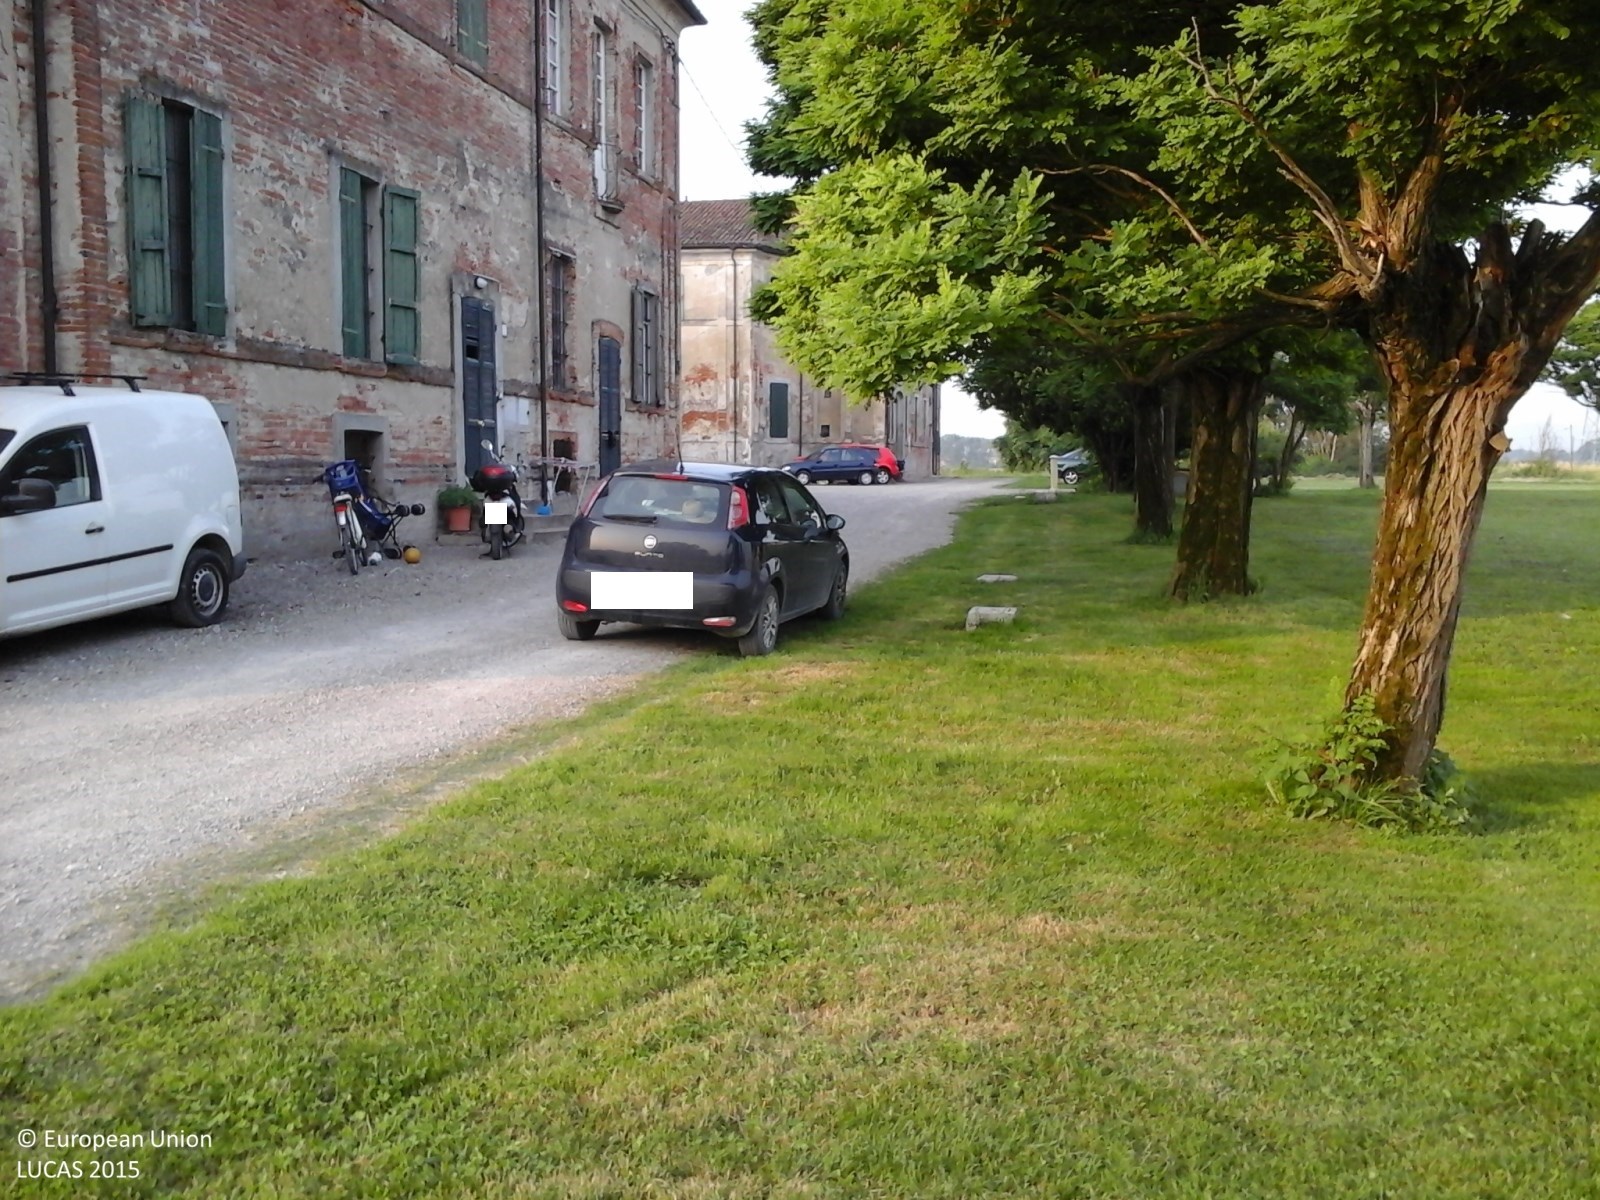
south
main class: Grassland
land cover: Grassland with sparse tree/shrub cover
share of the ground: > 75 %
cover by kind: herbaceous plants 95 %, broadleaved forest trees 5 %
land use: Agriculture (excluding fallow land and kitchen gardens)
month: May
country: IT
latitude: 44.8734
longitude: 10.1642
